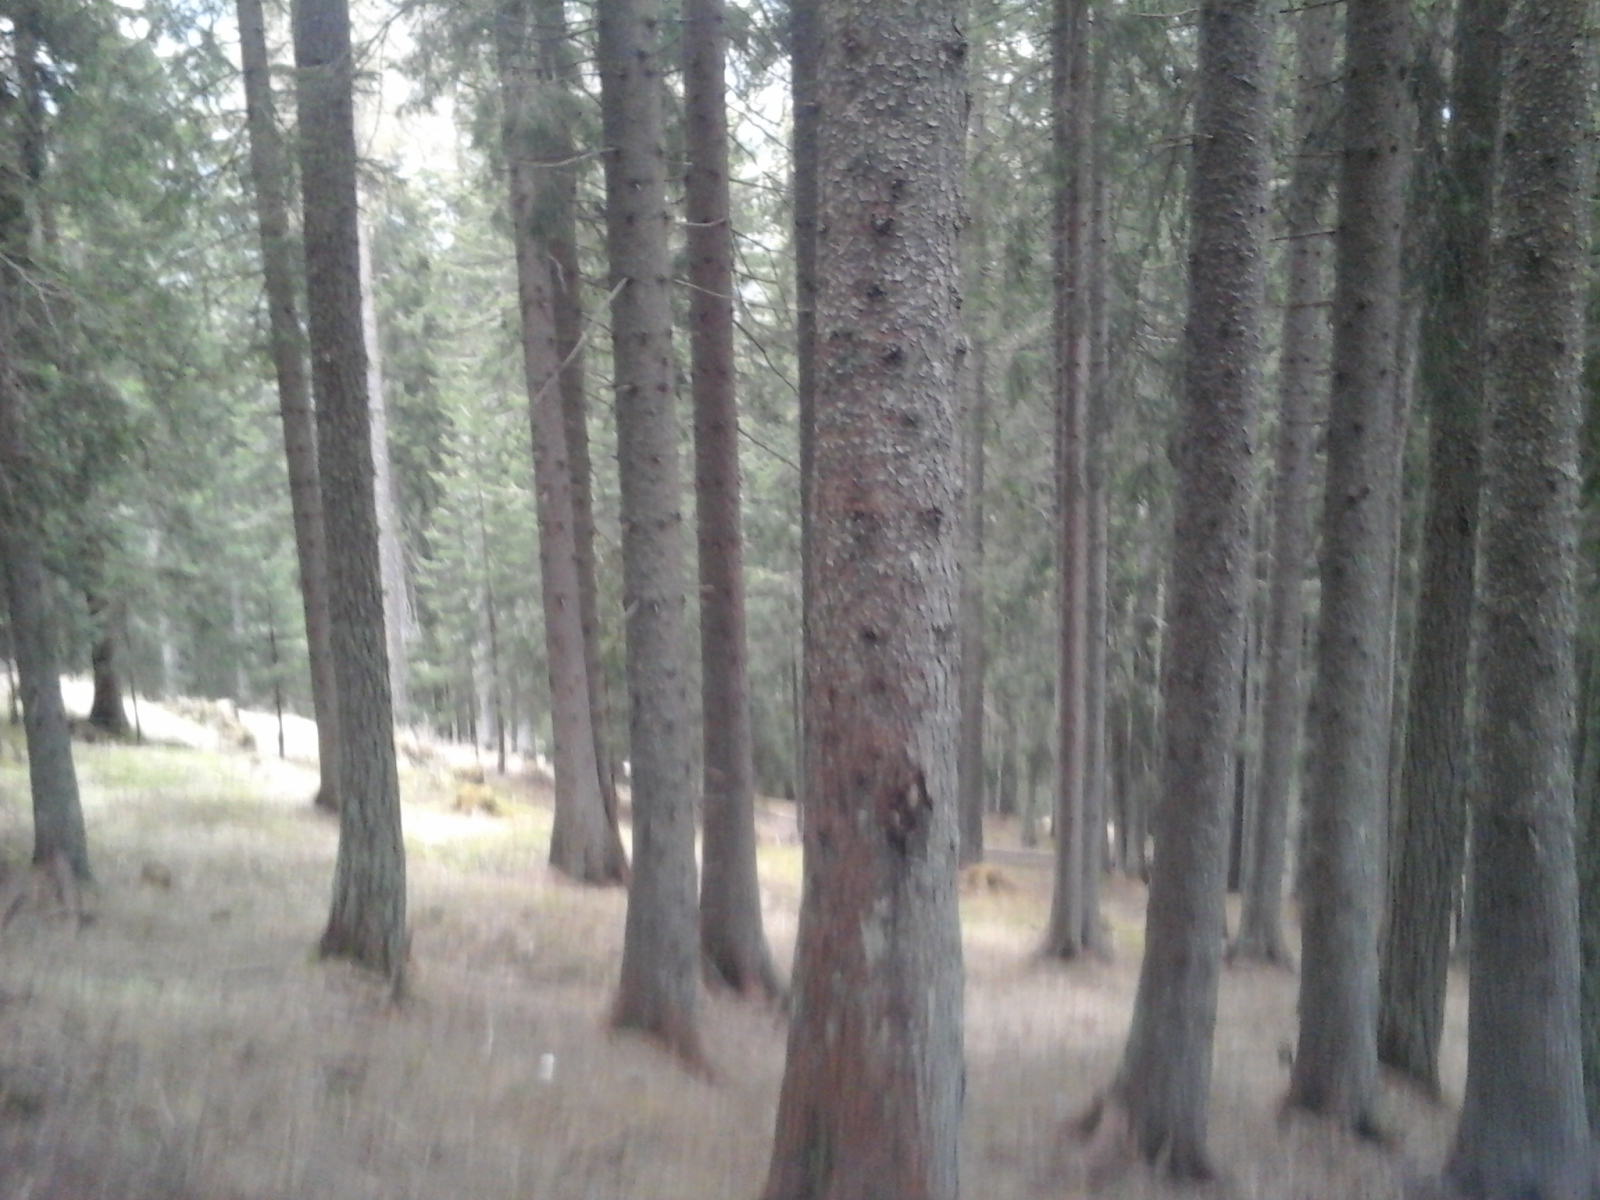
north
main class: Woodland
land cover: Spruce dominated coniferous woodland
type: alpine coniferous forest
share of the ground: > 75 %
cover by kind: coniferous forest trees 95 %, herbaceous plants 5 %
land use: Forestry
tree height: > 5 m
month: May
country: IT
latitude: 46.3929
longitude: 11.6236
